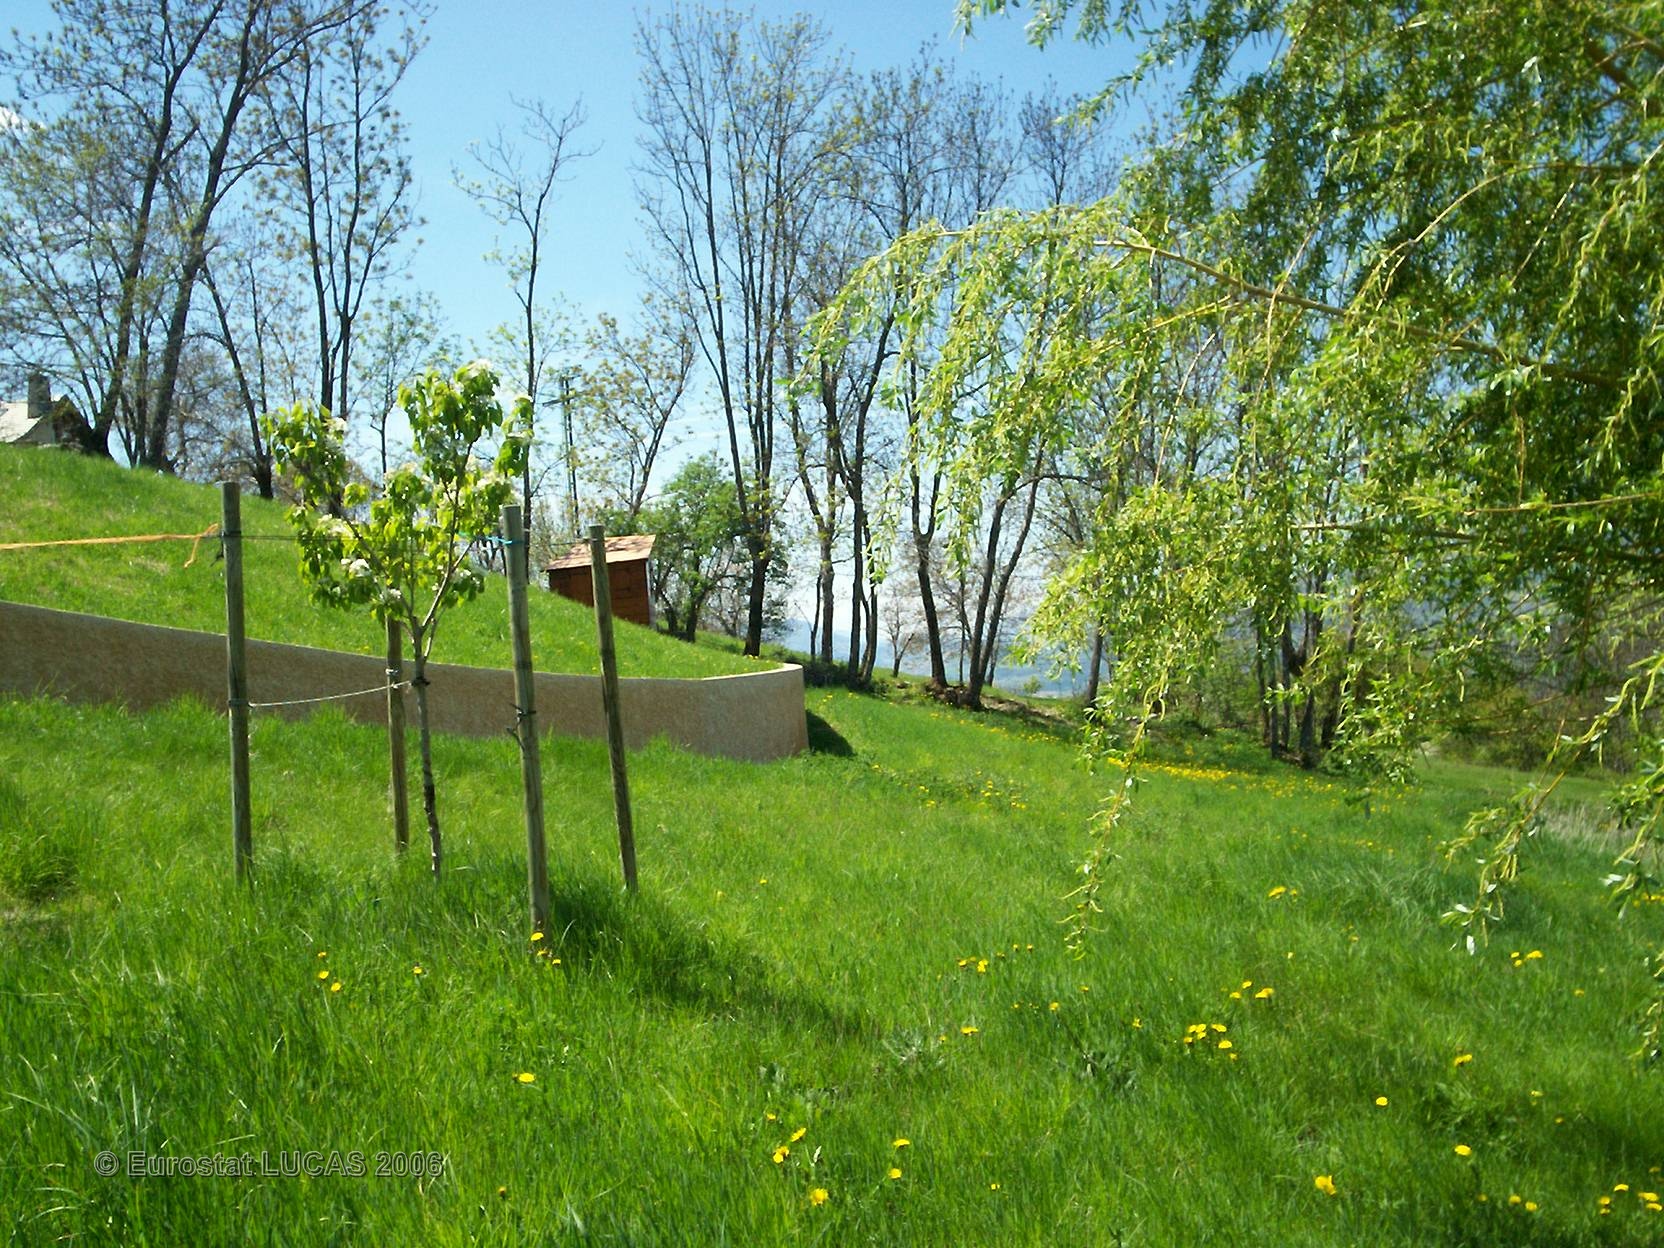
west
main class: Grassland
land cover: Grassland with sparse tree/shrub cover
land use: Agriculture (excluding fallow land and kitchen gardens)
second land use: Residential
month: May
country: FR
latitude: 44.5252
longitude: 6.4707
